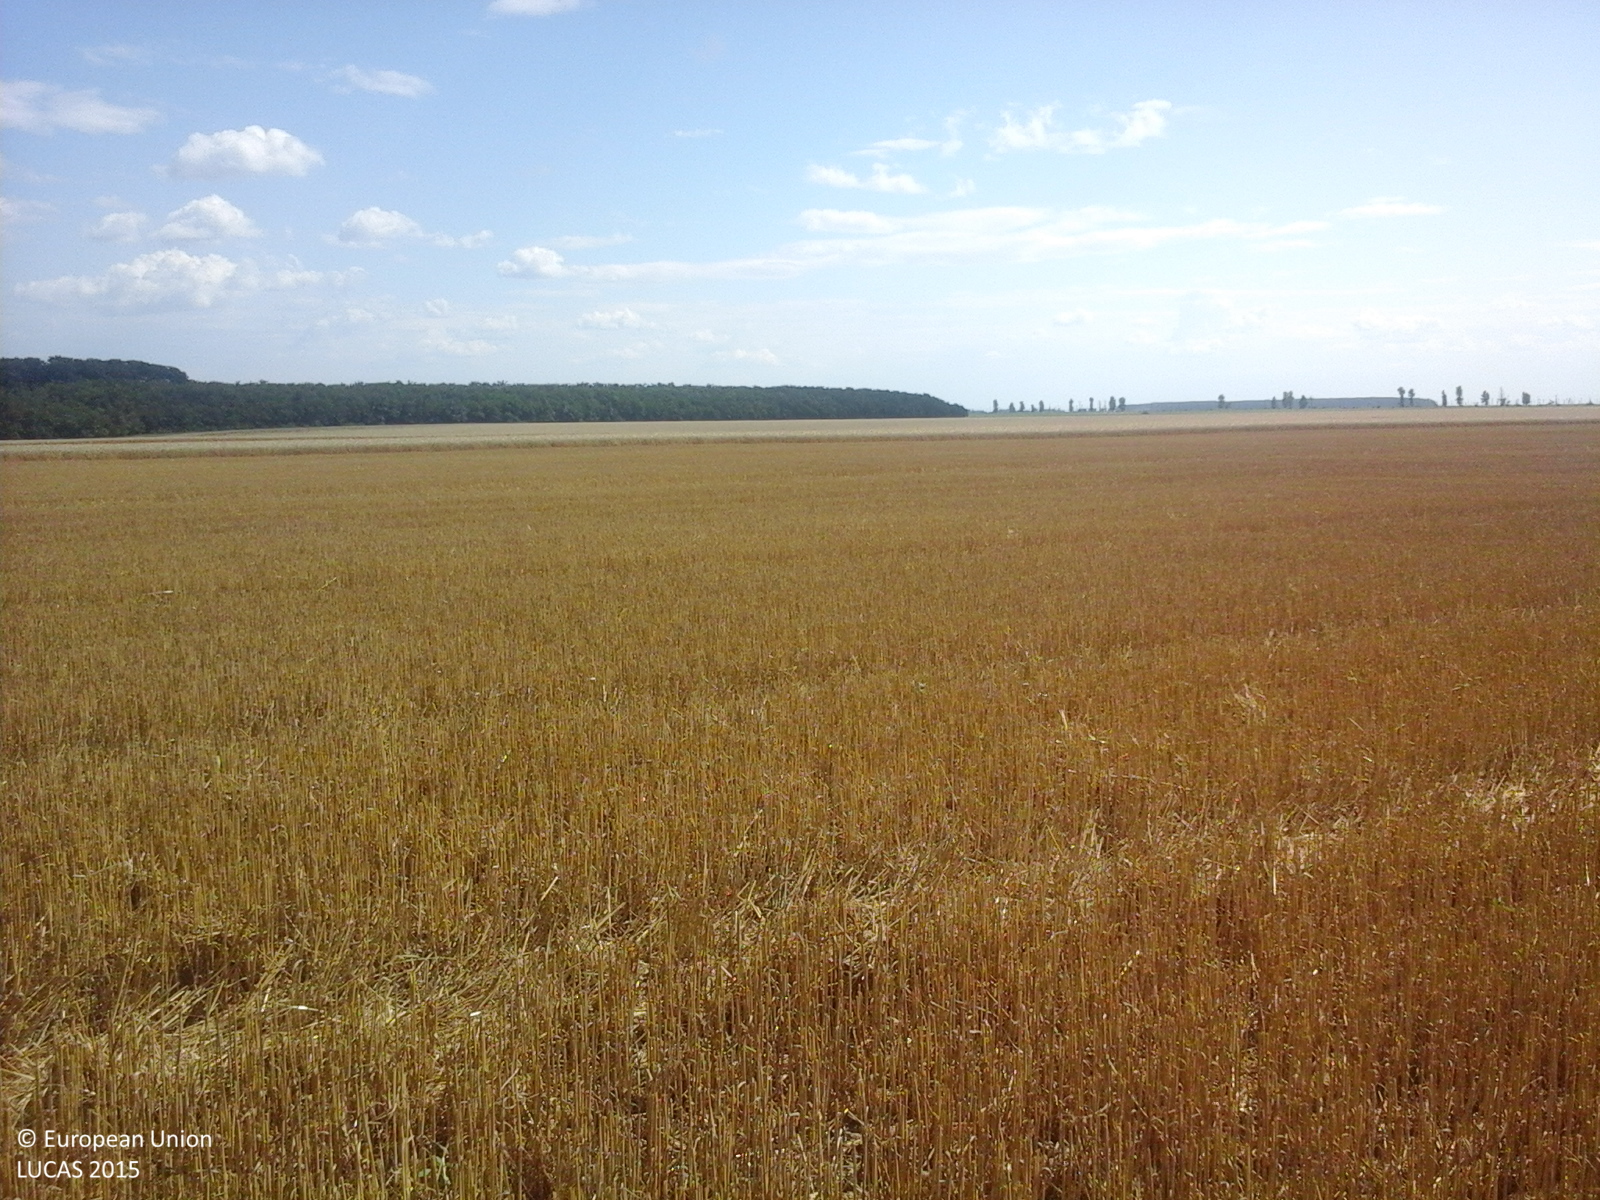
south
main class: Cropland
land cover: Common wheat
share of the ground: < 10 %
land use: Agriculture (excluding fallow land and kitchen gardens)
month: July
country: RO
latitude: 44.3508
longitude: 25.3801
